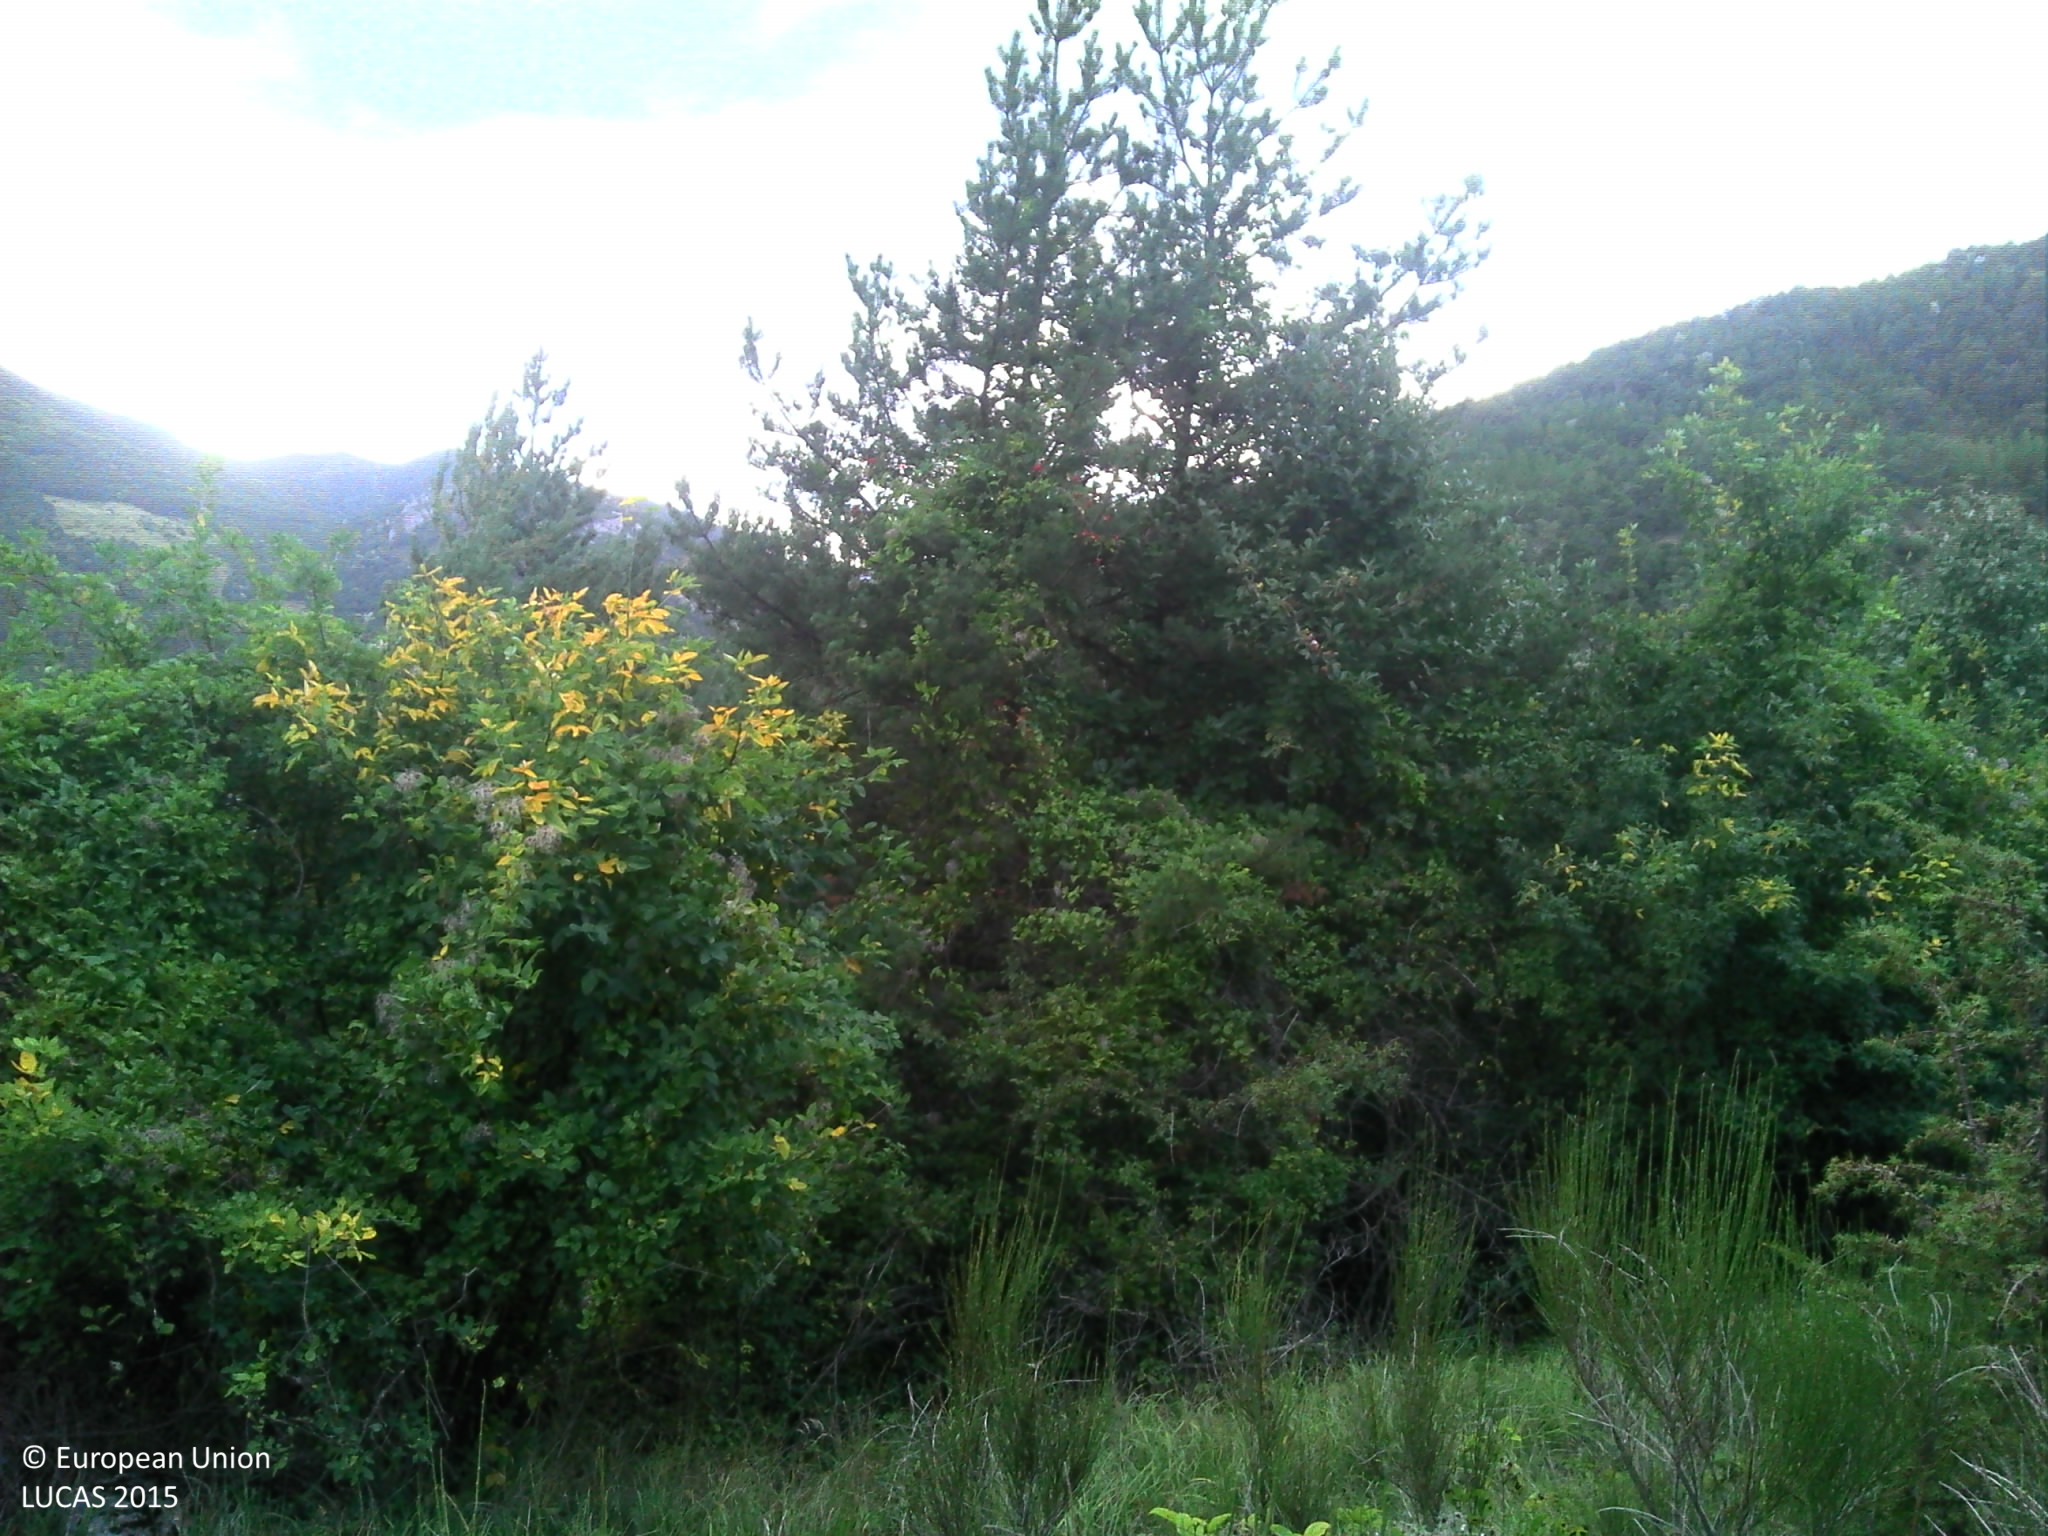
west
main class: Woodland
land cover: Pine dominated coniferous woodland
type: alpine coniferous forest
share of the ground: > 75 %
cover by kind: coniferous forest trees 75 %, shrubs 10 %, broadleaved forest trees 5 %, herbaceous plants 5 %, consolidated bare surface 5 %
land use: Forestry
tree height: > 5 m
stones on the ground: < 10 %
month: September
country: FR
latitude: 44.4367
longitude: 5.5723
